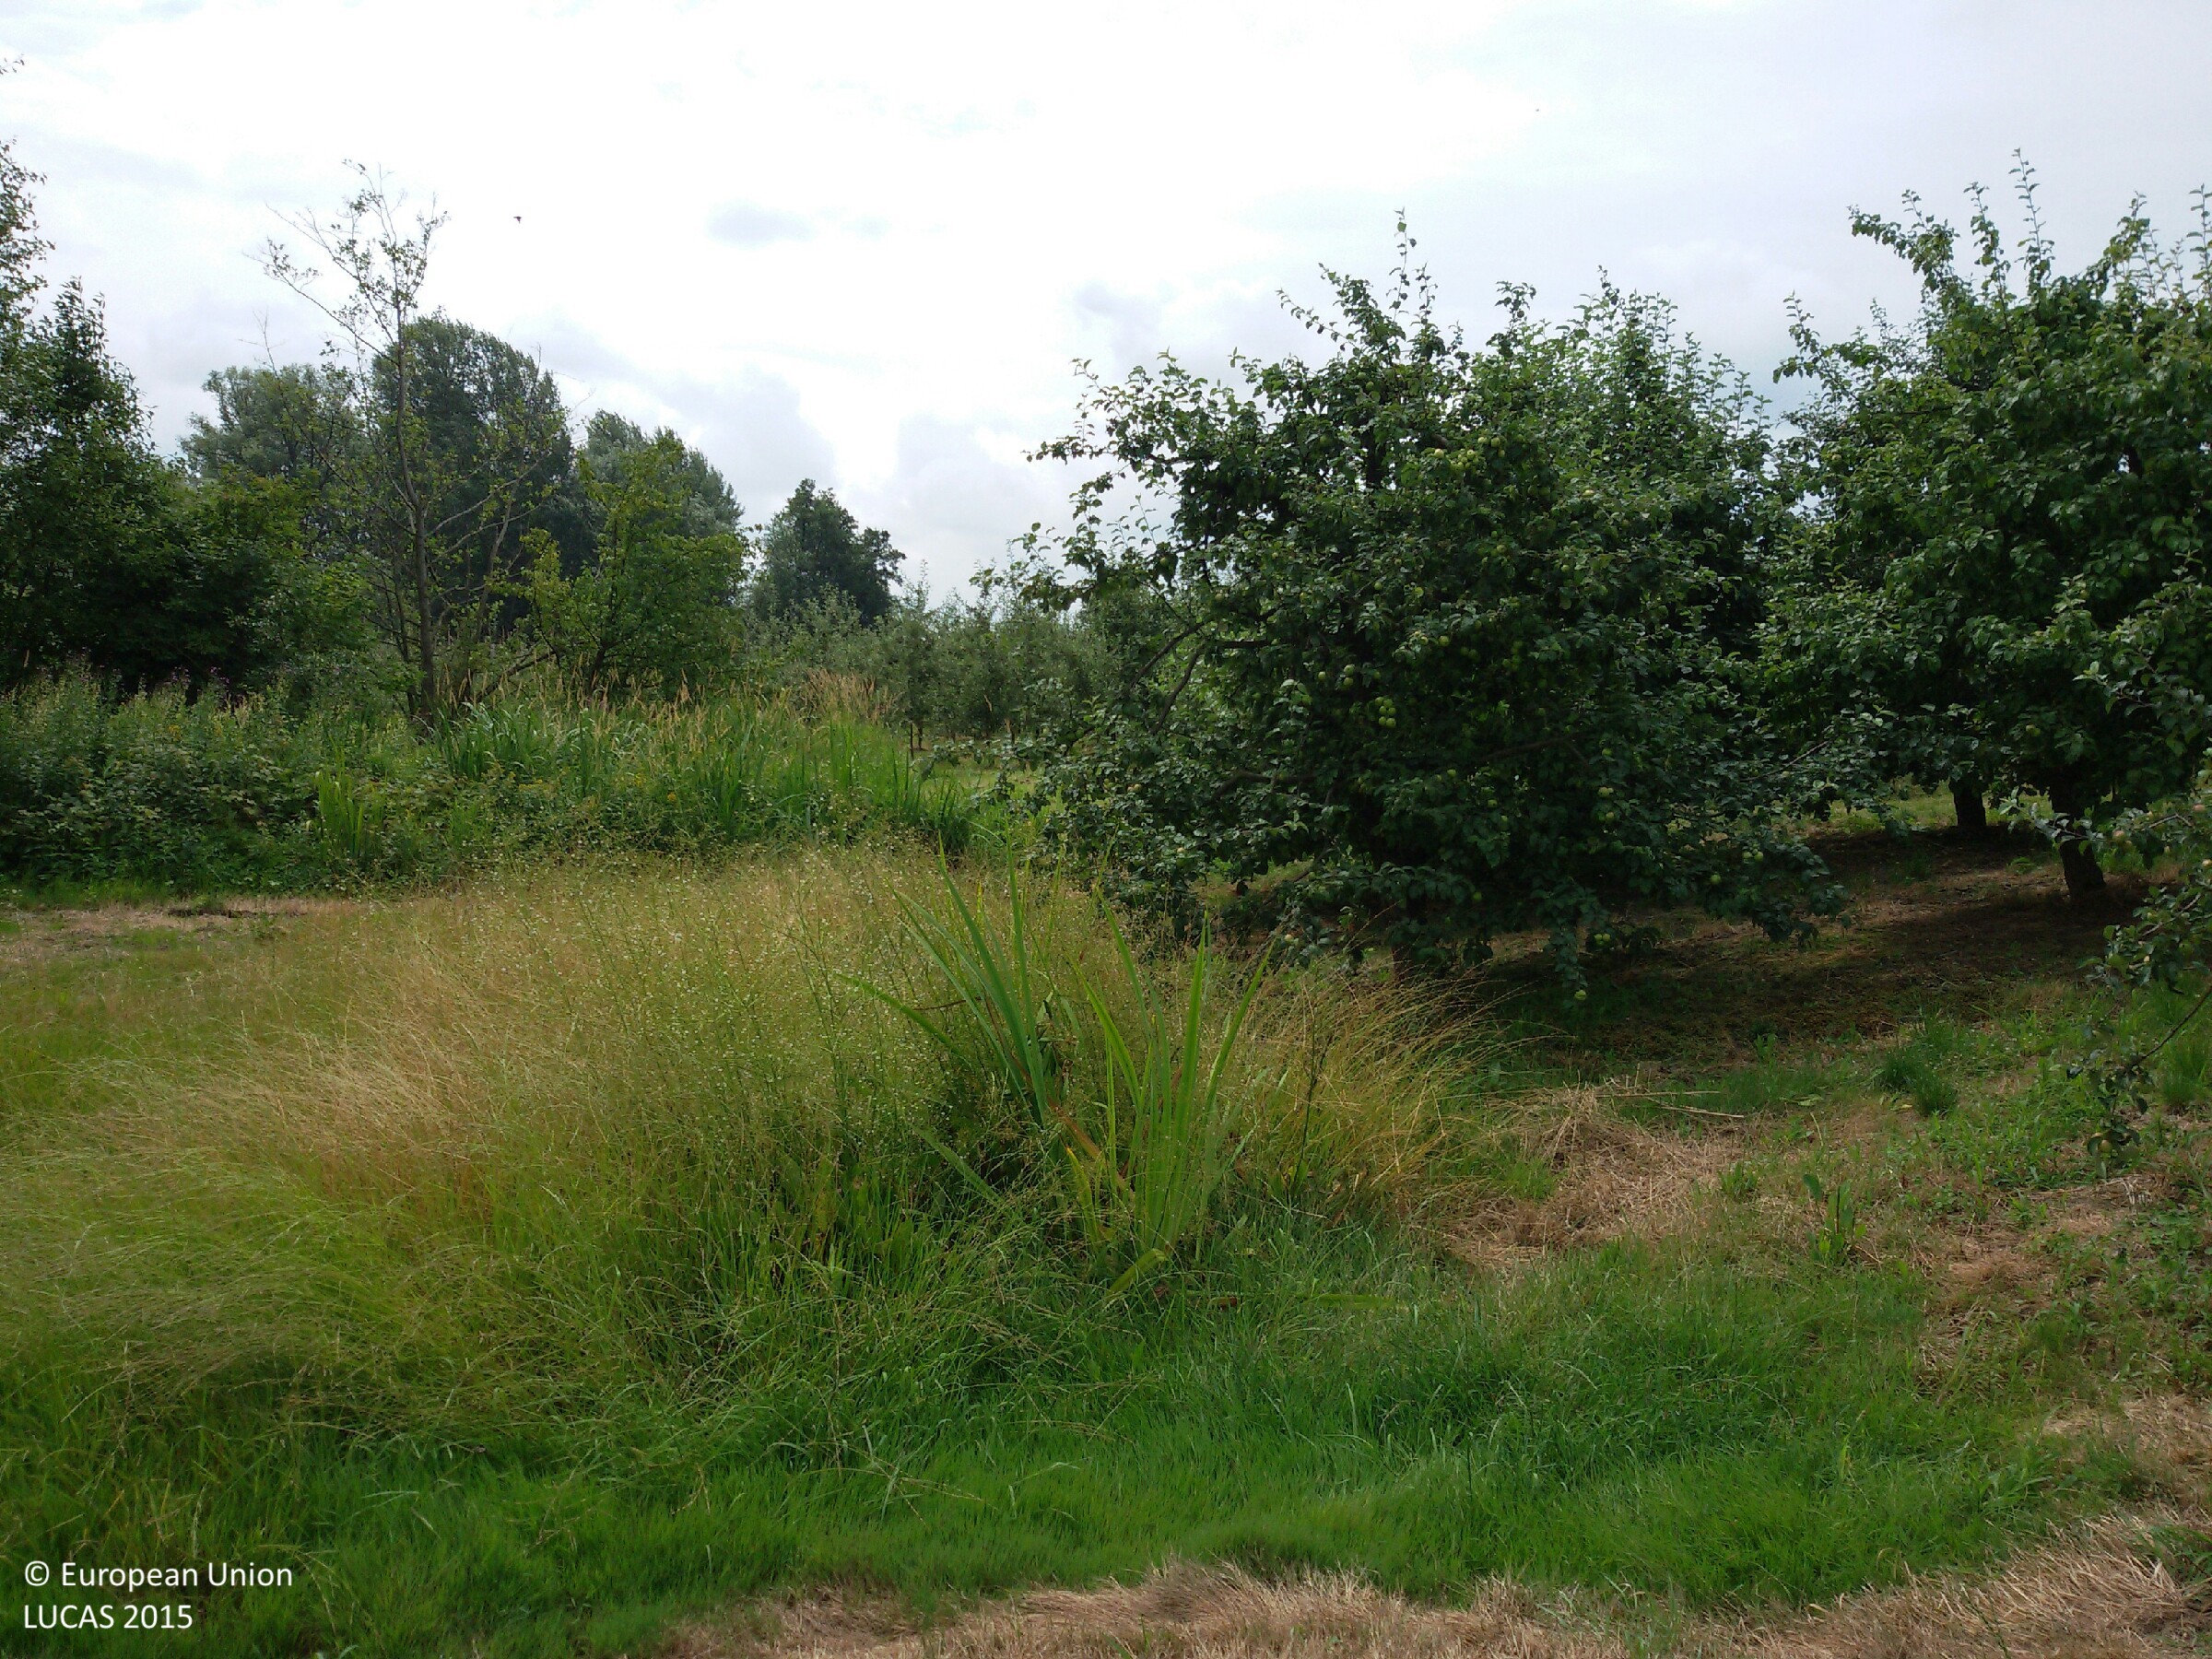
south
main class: Grassland
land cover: Grassland without tree/shrub cover
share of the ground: > 75 %
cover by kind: herbaceous plants 100 %
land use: Agriculture (excluding fallow land and kitchen gardens)
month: July
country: PL
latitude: 51.2013
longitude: 21.8346
